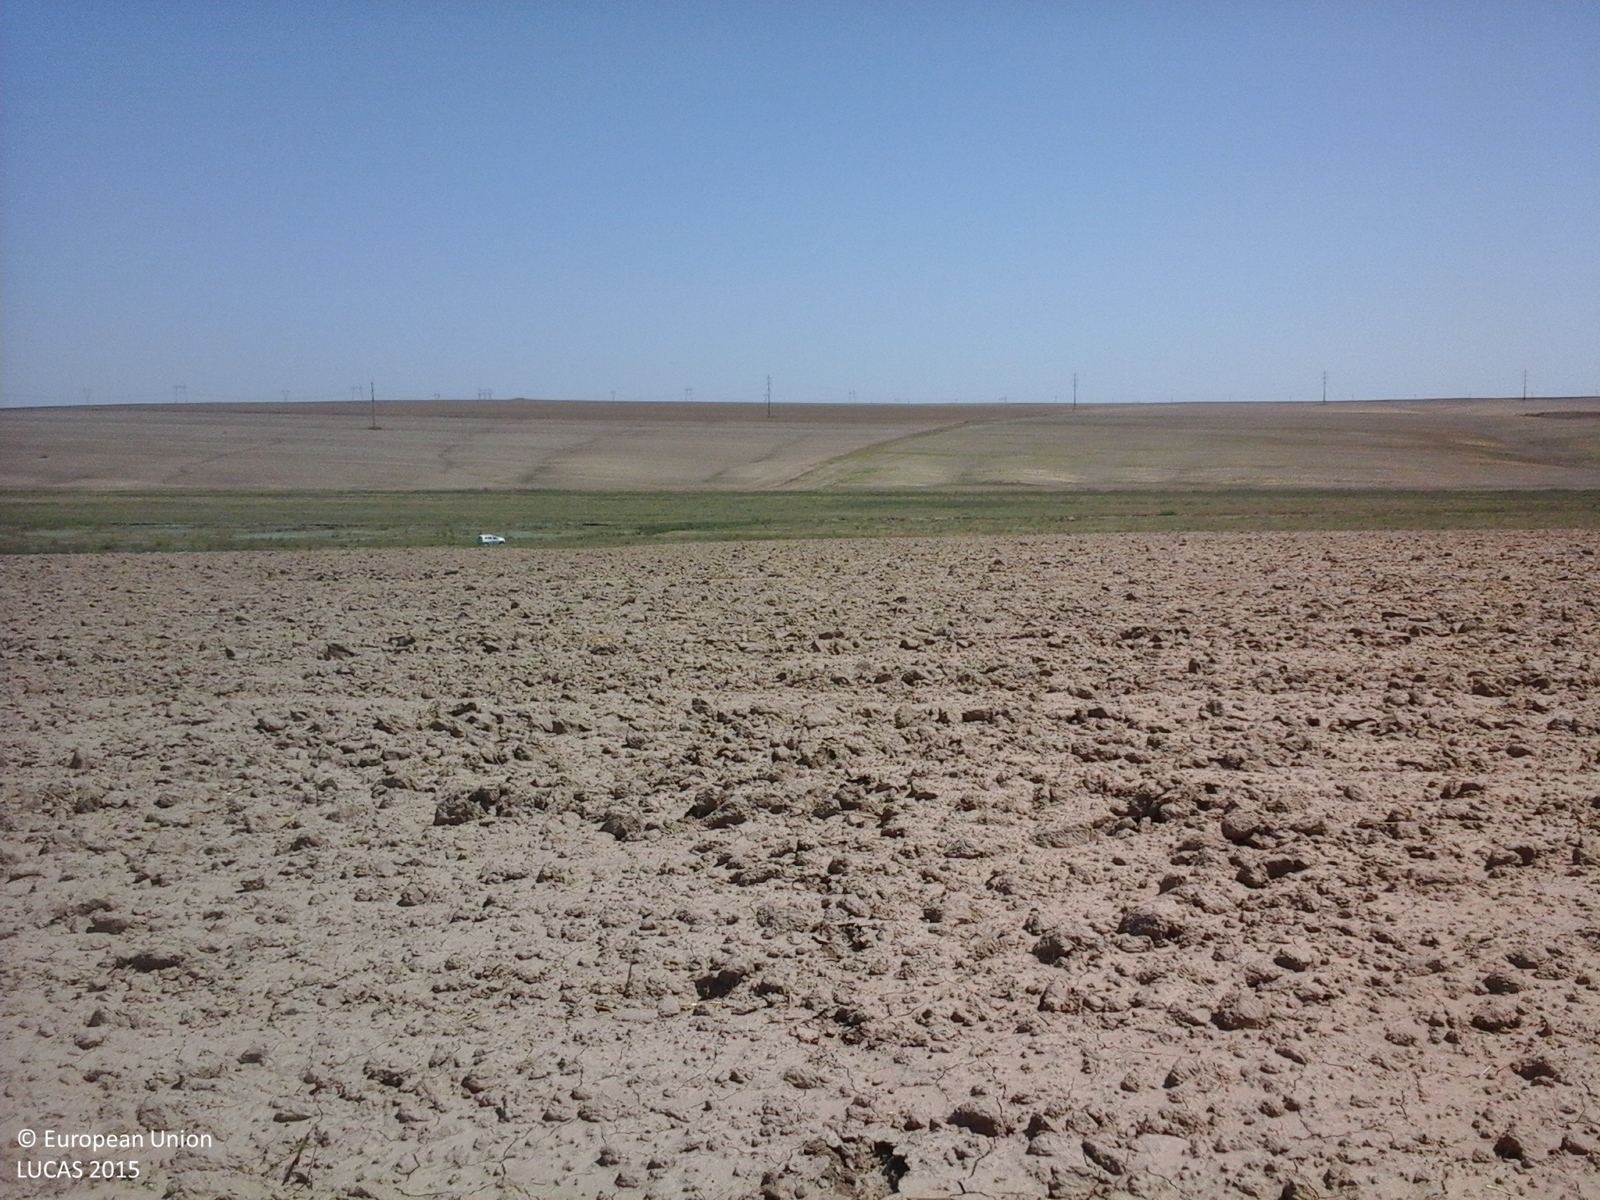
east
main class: Cropland
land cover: Common wheat
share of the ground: < 10 %
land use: Agriculture (excluding fallow land and kitchen gardens)
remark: Harvested field
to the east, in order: Common wheat; Grassland without tree/shrub cover
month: August
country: RO
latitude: 44.4634
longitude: 28.1744
